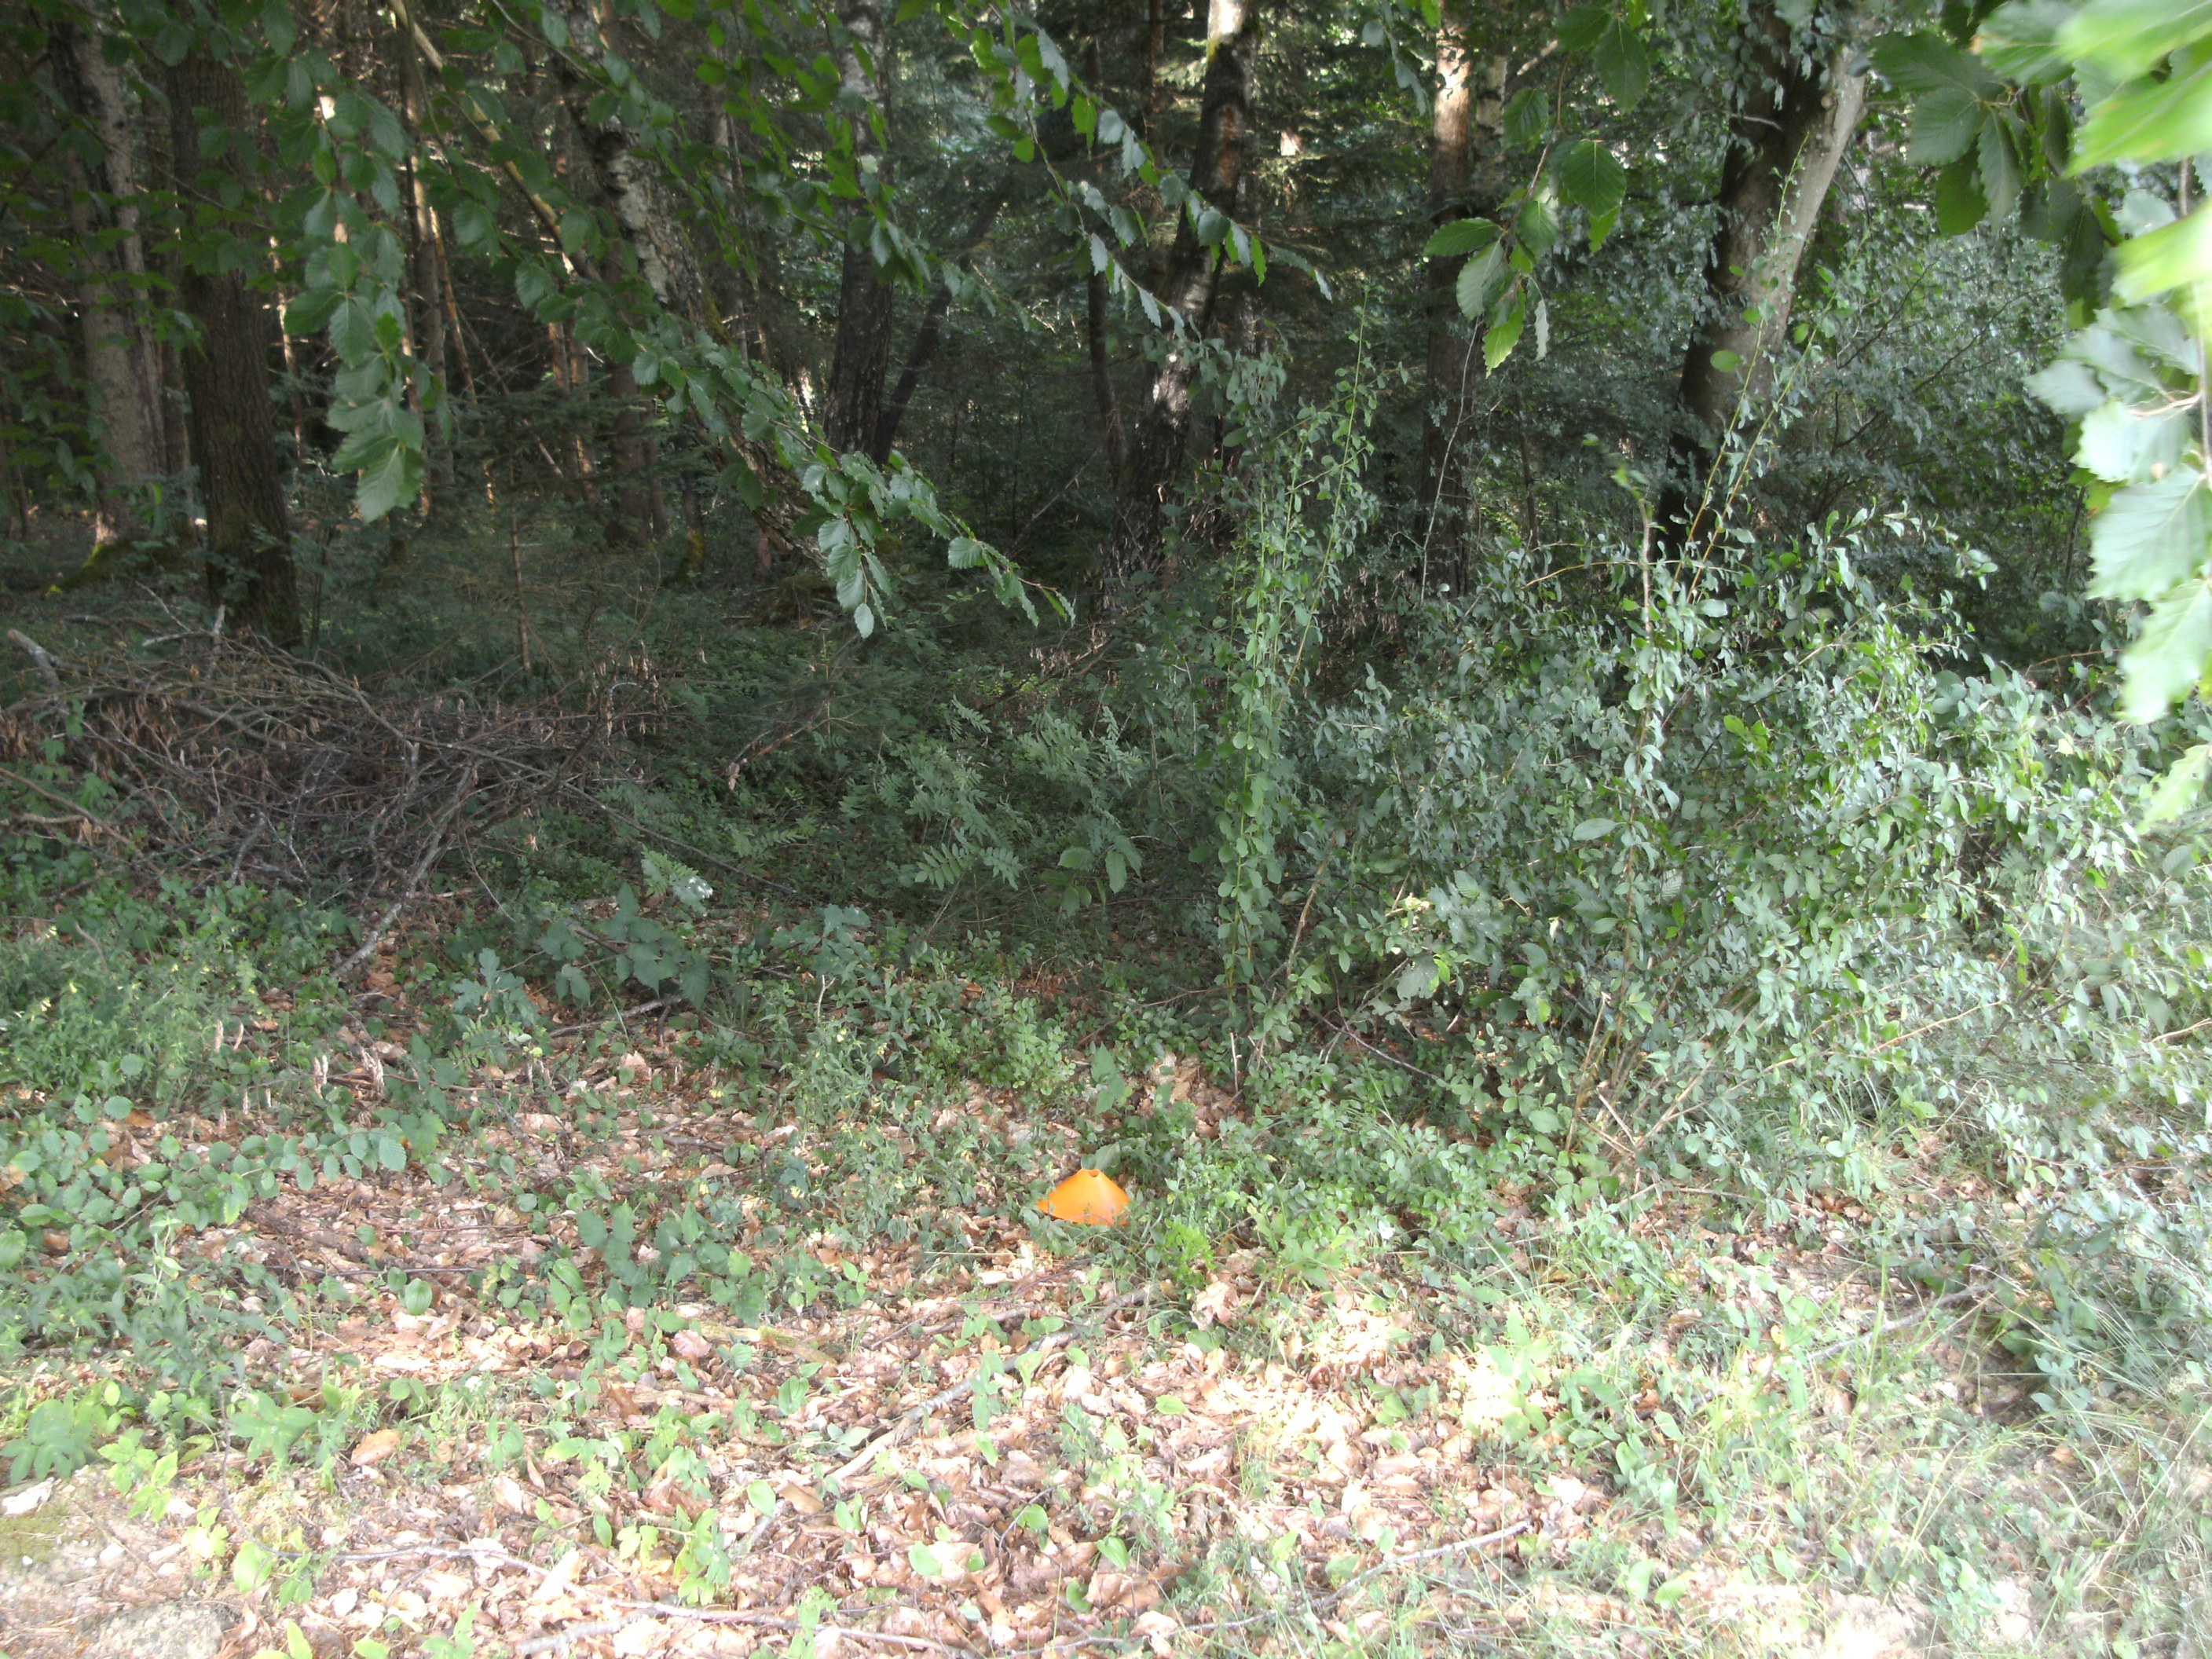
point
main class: Woodland
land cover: Spruce dominated mixed woodland
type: hemiboreal forest and nemoral coniferous forest and mixed broadleaved-coniferous forest
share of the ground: > 75 %
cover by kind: coniferous forest trees 45 %, broadleaved forest trees 45 %, shrubs 5 %, herbaceous plants 5 %
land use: Forestry
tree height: > 5 m
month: July
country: AT
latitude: 46.5600
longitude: 14.5762
